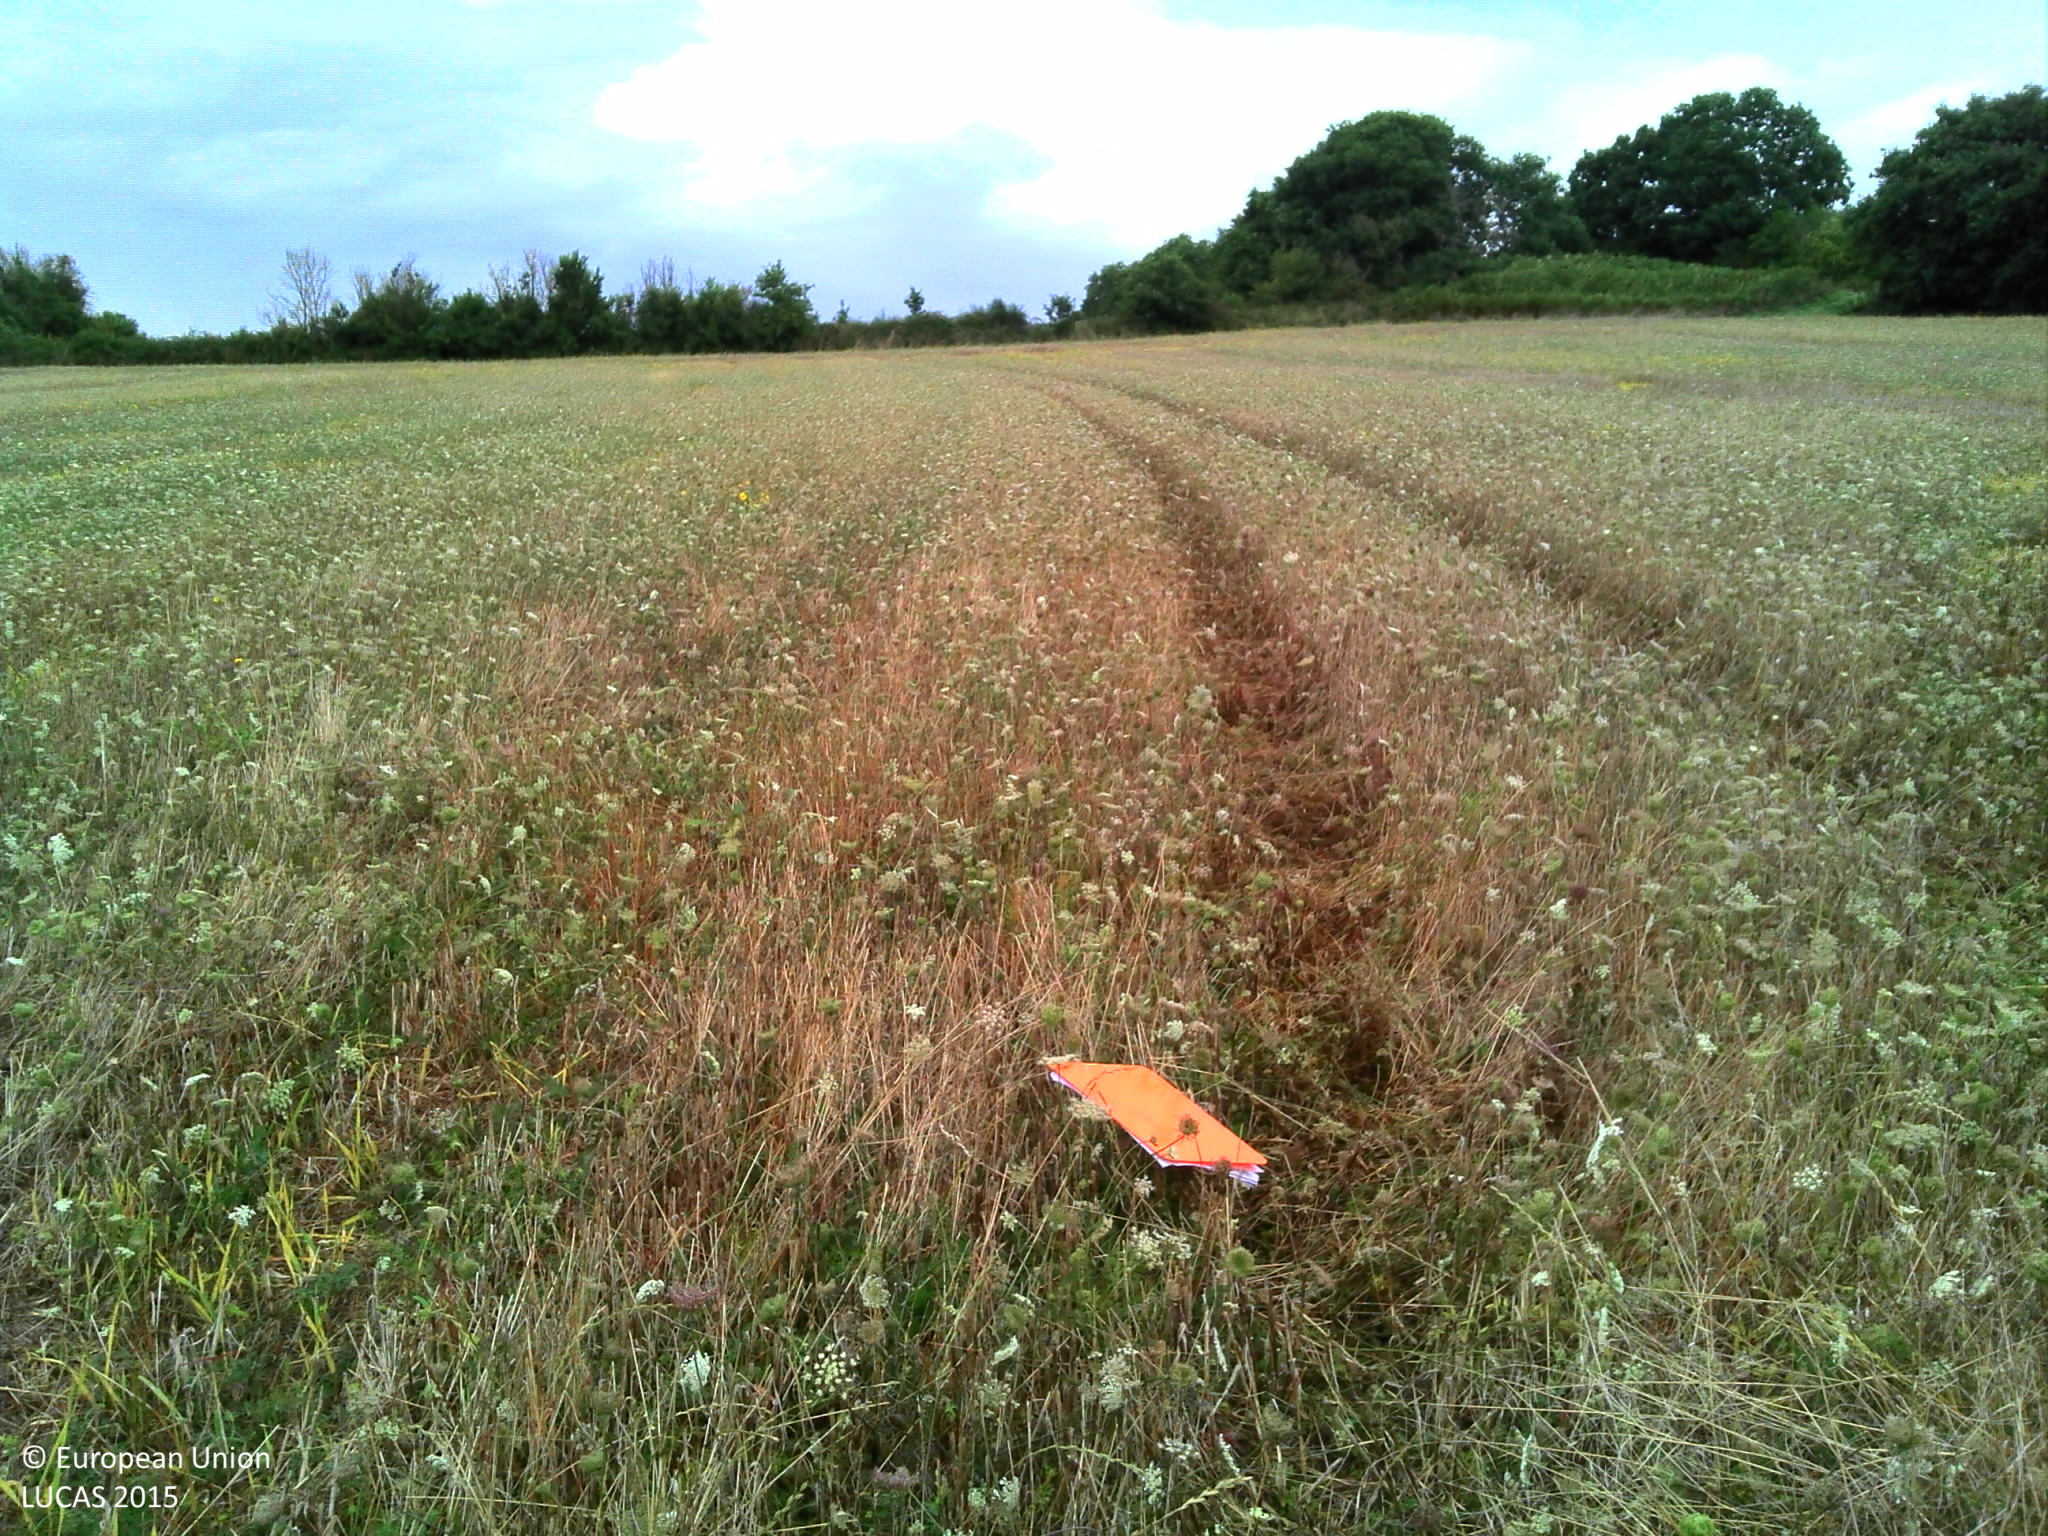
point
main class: Grassland
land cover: Spontaneously vegetated surfaces
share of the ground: > 75 %
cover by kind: herbaceous plants 100 %
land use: Fallow land
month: August
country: FR
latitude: 48.5872
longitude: -2.1356
